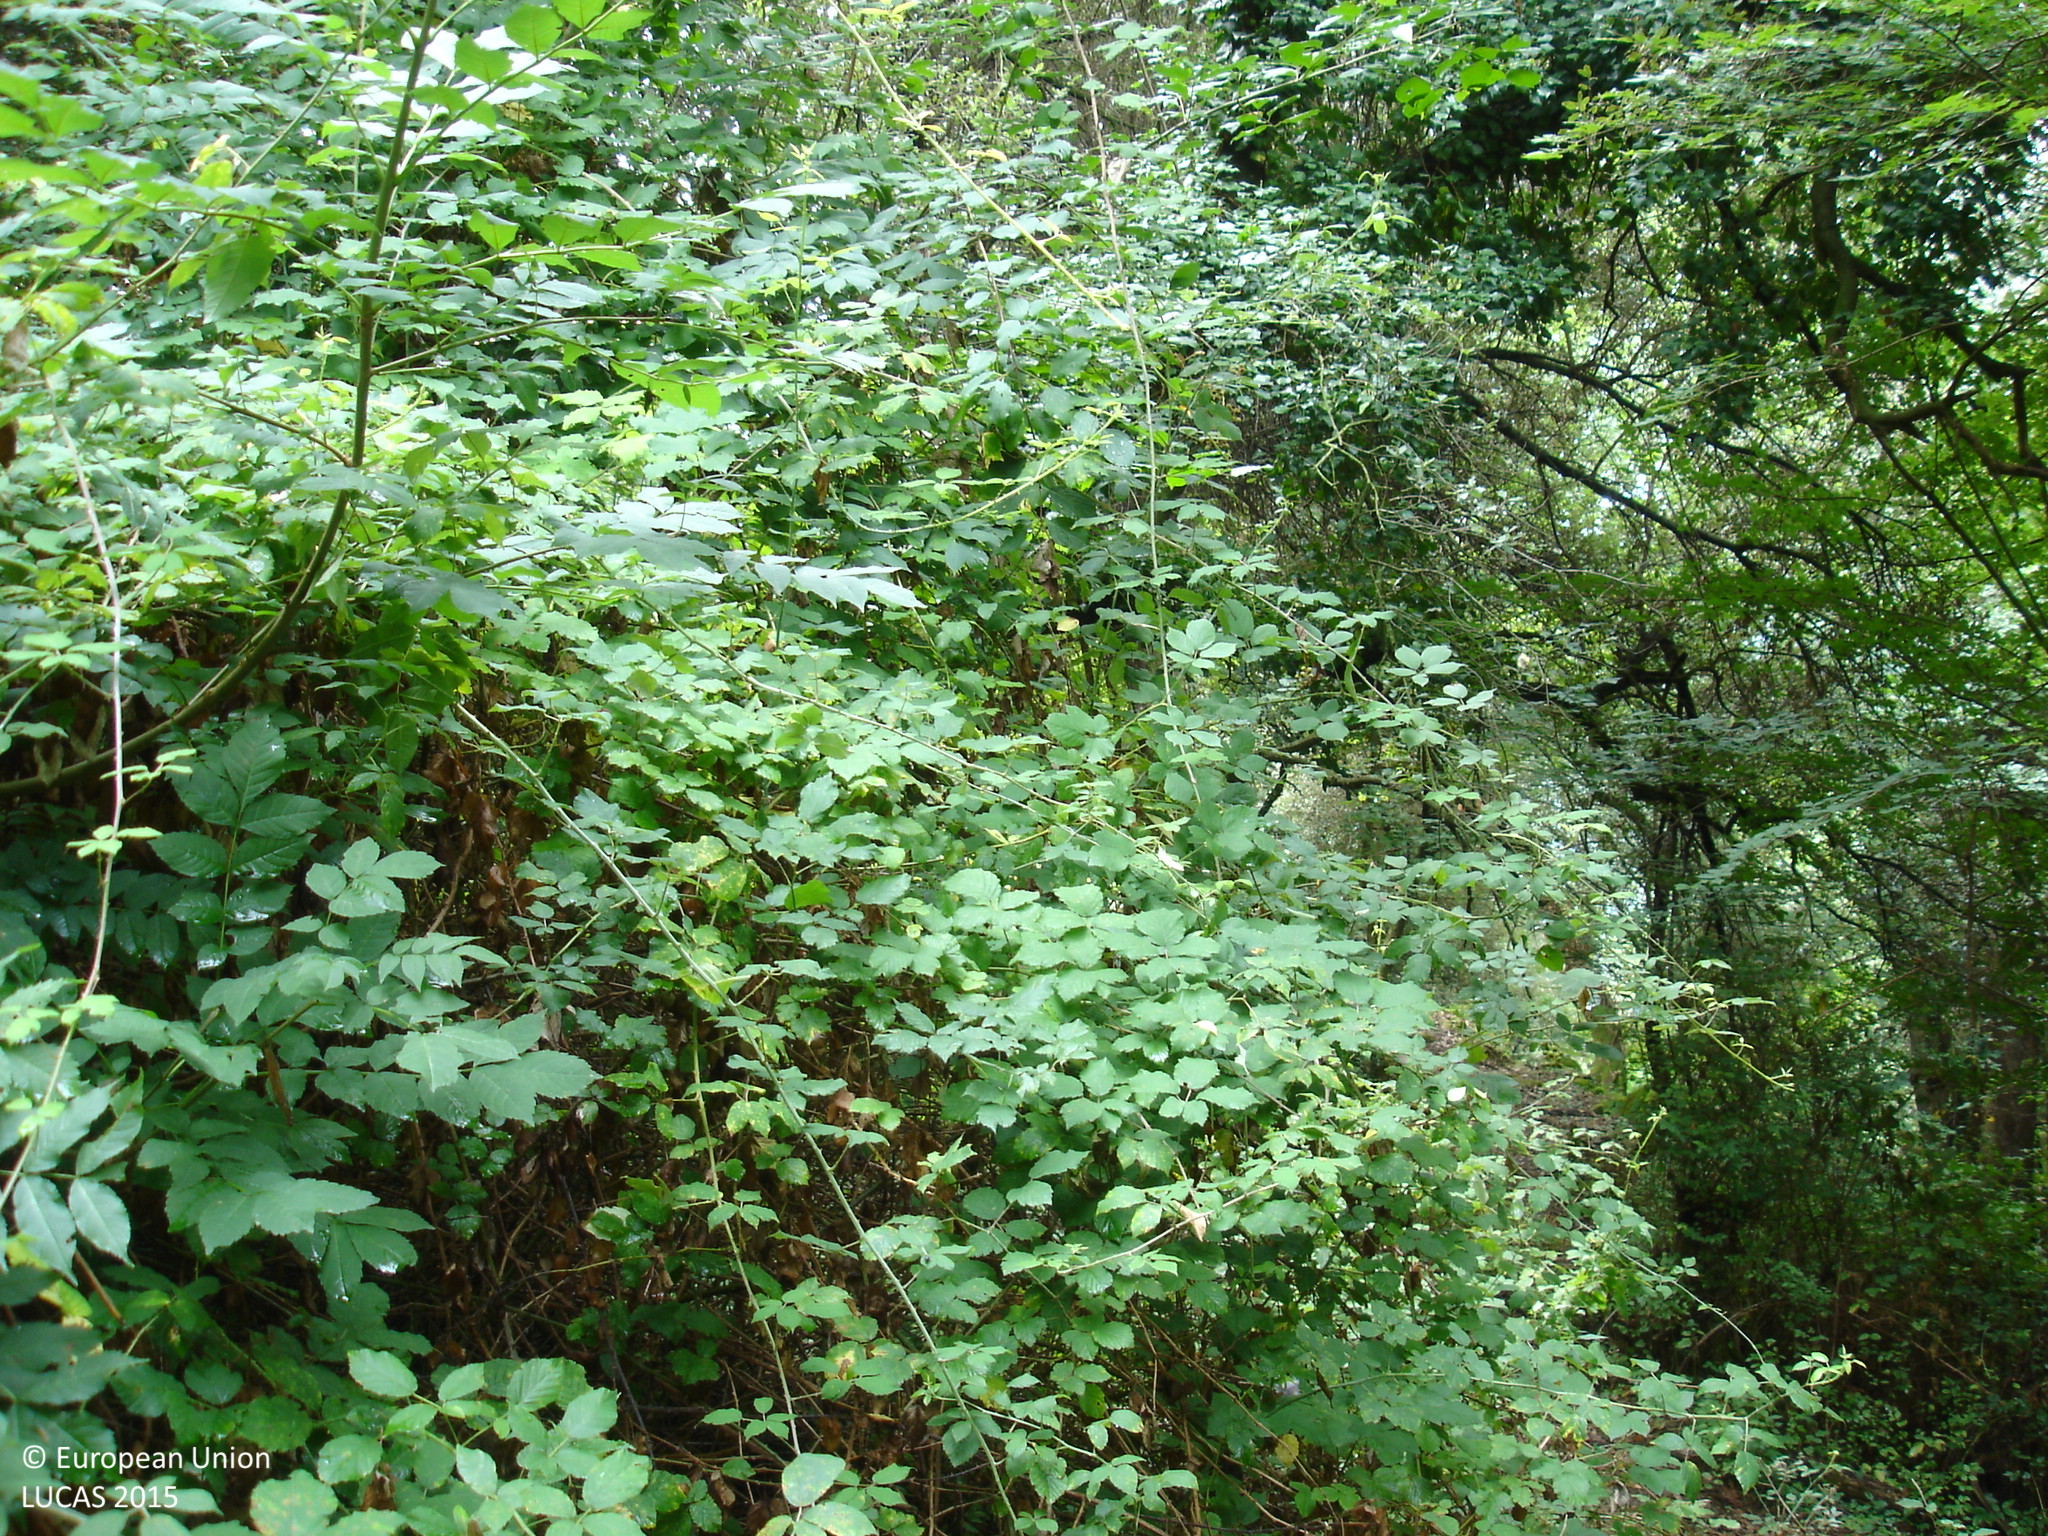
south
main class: Woodland
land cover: Broadleaved woodland
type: thermophilous deciduous forest
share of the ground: > 75 %
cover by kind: broadleaved forest trees 80 %, shrubs 15 %, herbaceous plants 5 %
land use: Semi-natural and natural areas not in use
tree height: > 5 m
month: July
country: ES
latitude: 42.1418
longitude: 2.5245
